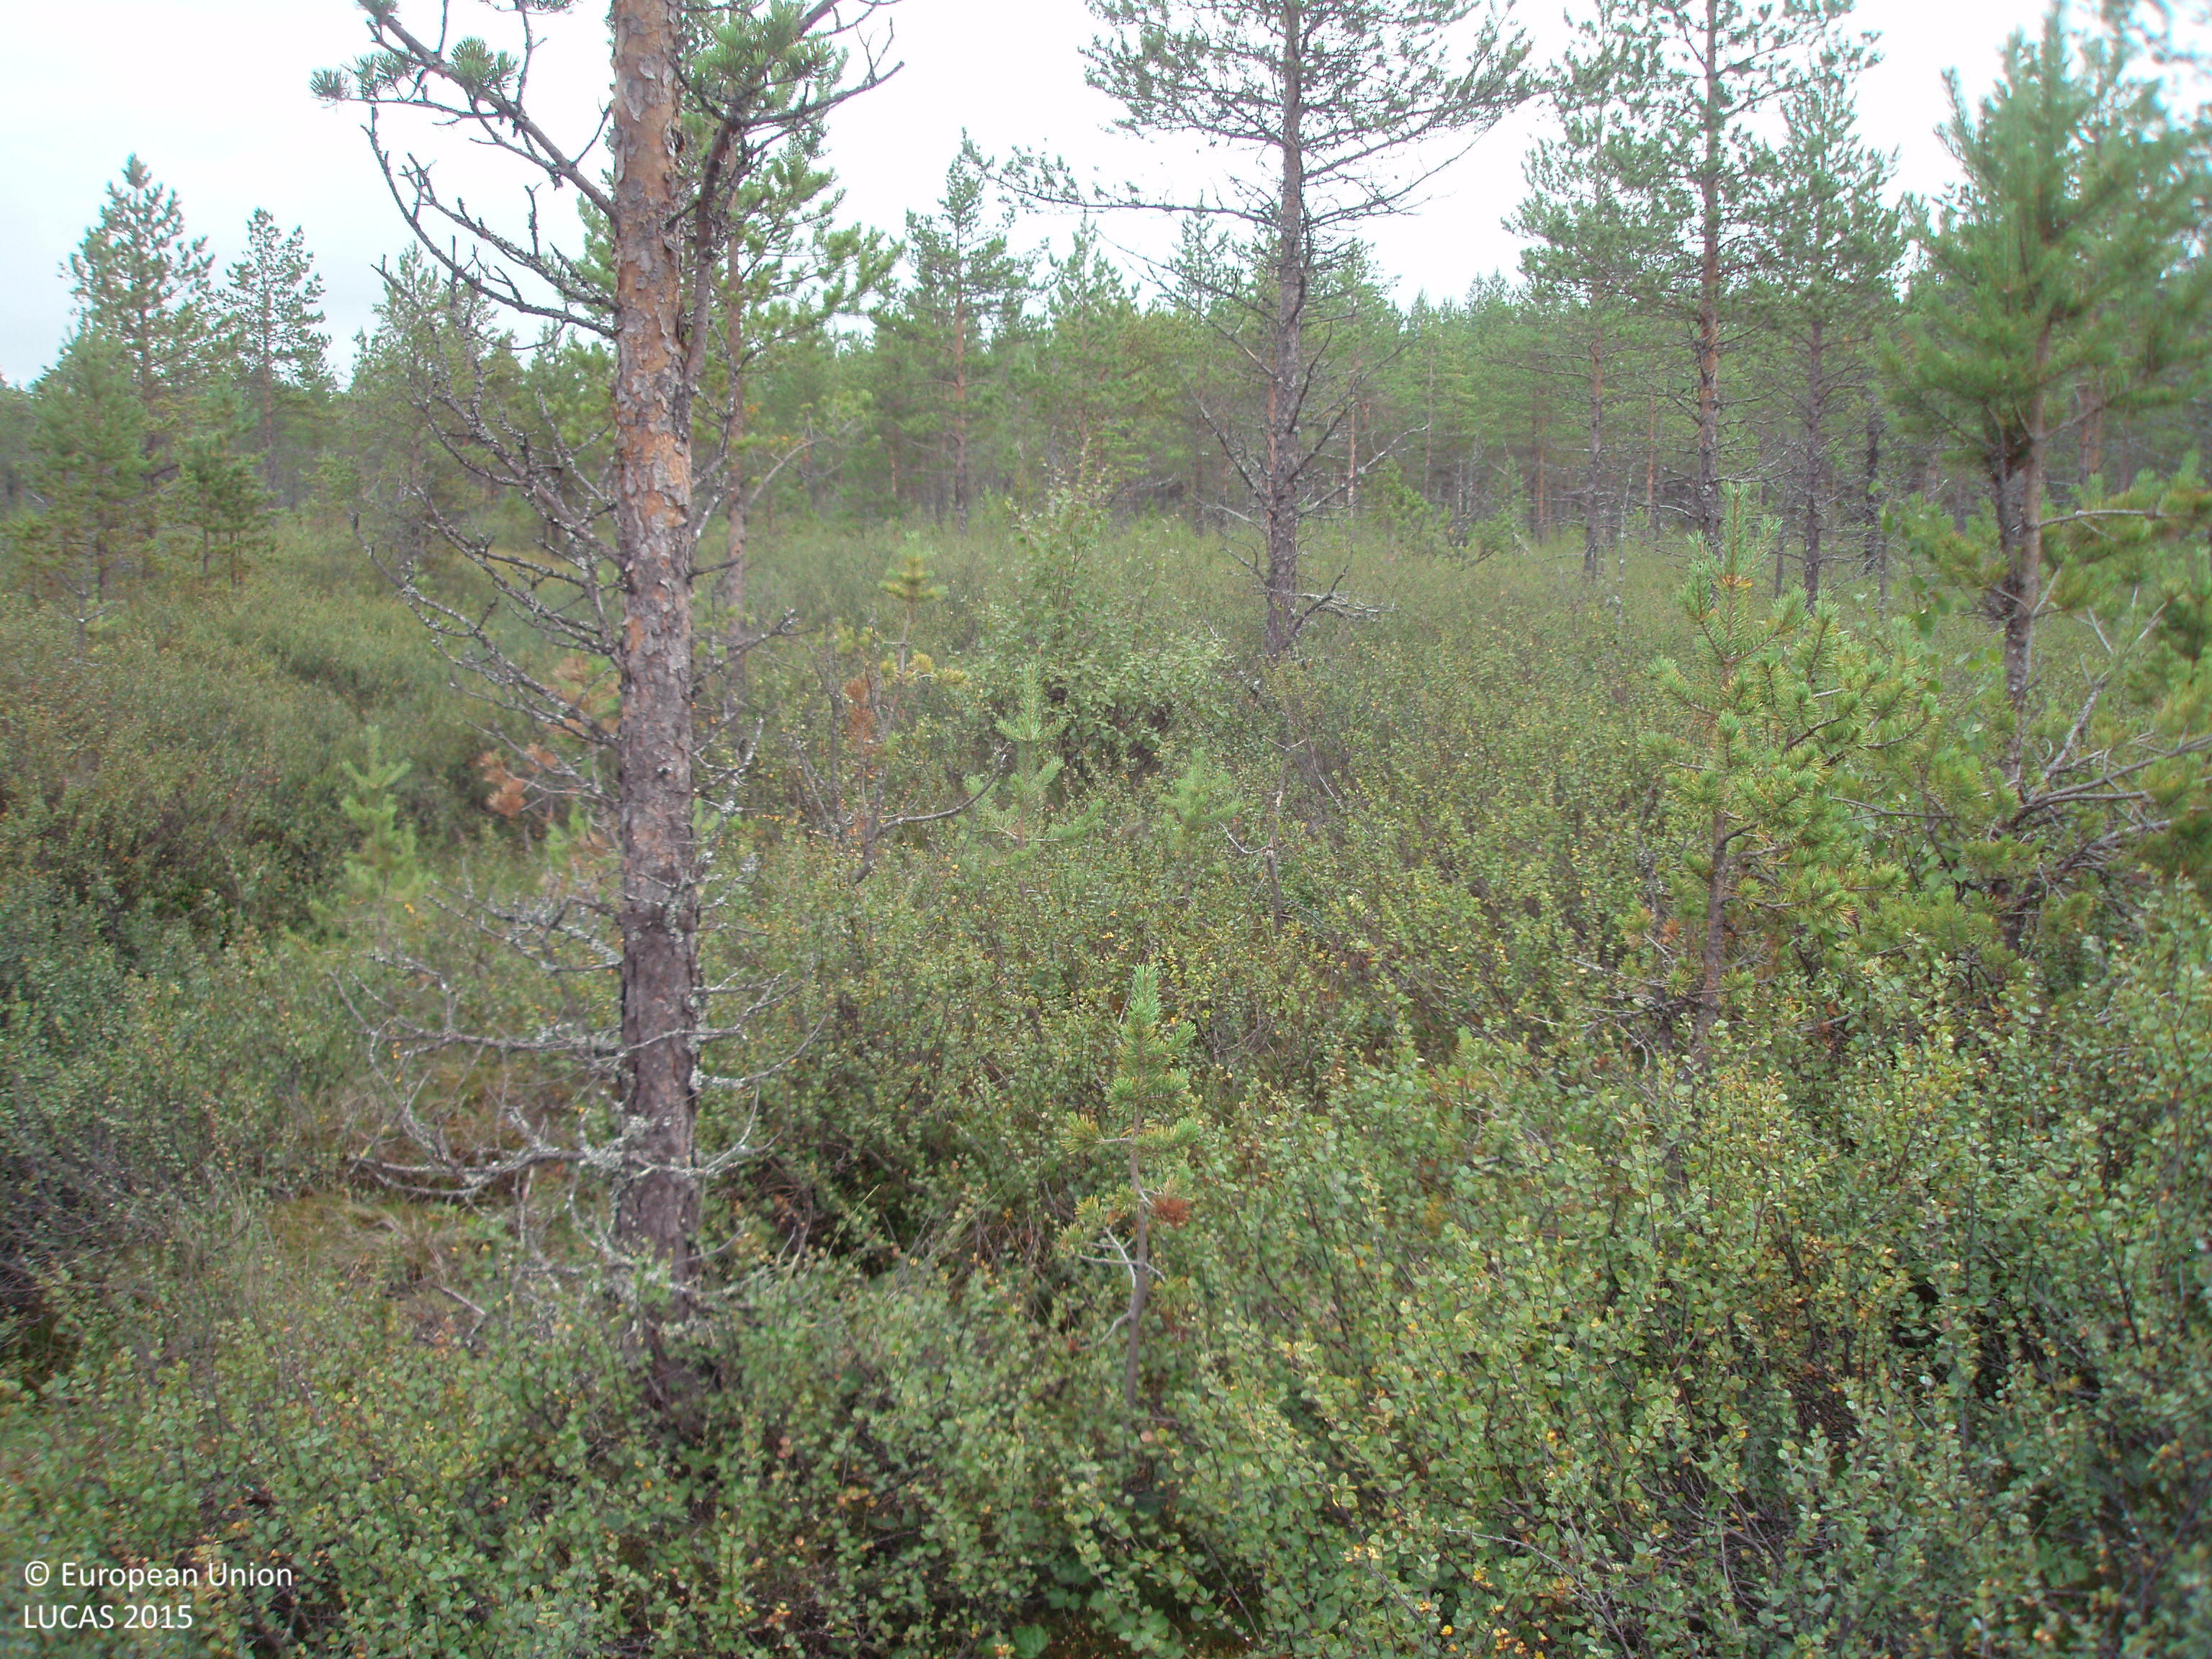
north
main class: Woodland
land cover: Pine dominated coniferous woodland
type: boreal forest
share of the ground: 10 - 25 %
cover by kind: shrubs 80 %, coniferous forest trees 20 %
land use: Forestry
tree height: > 5 m
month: August
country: FI
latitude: 65.4712
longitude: 27.0632
